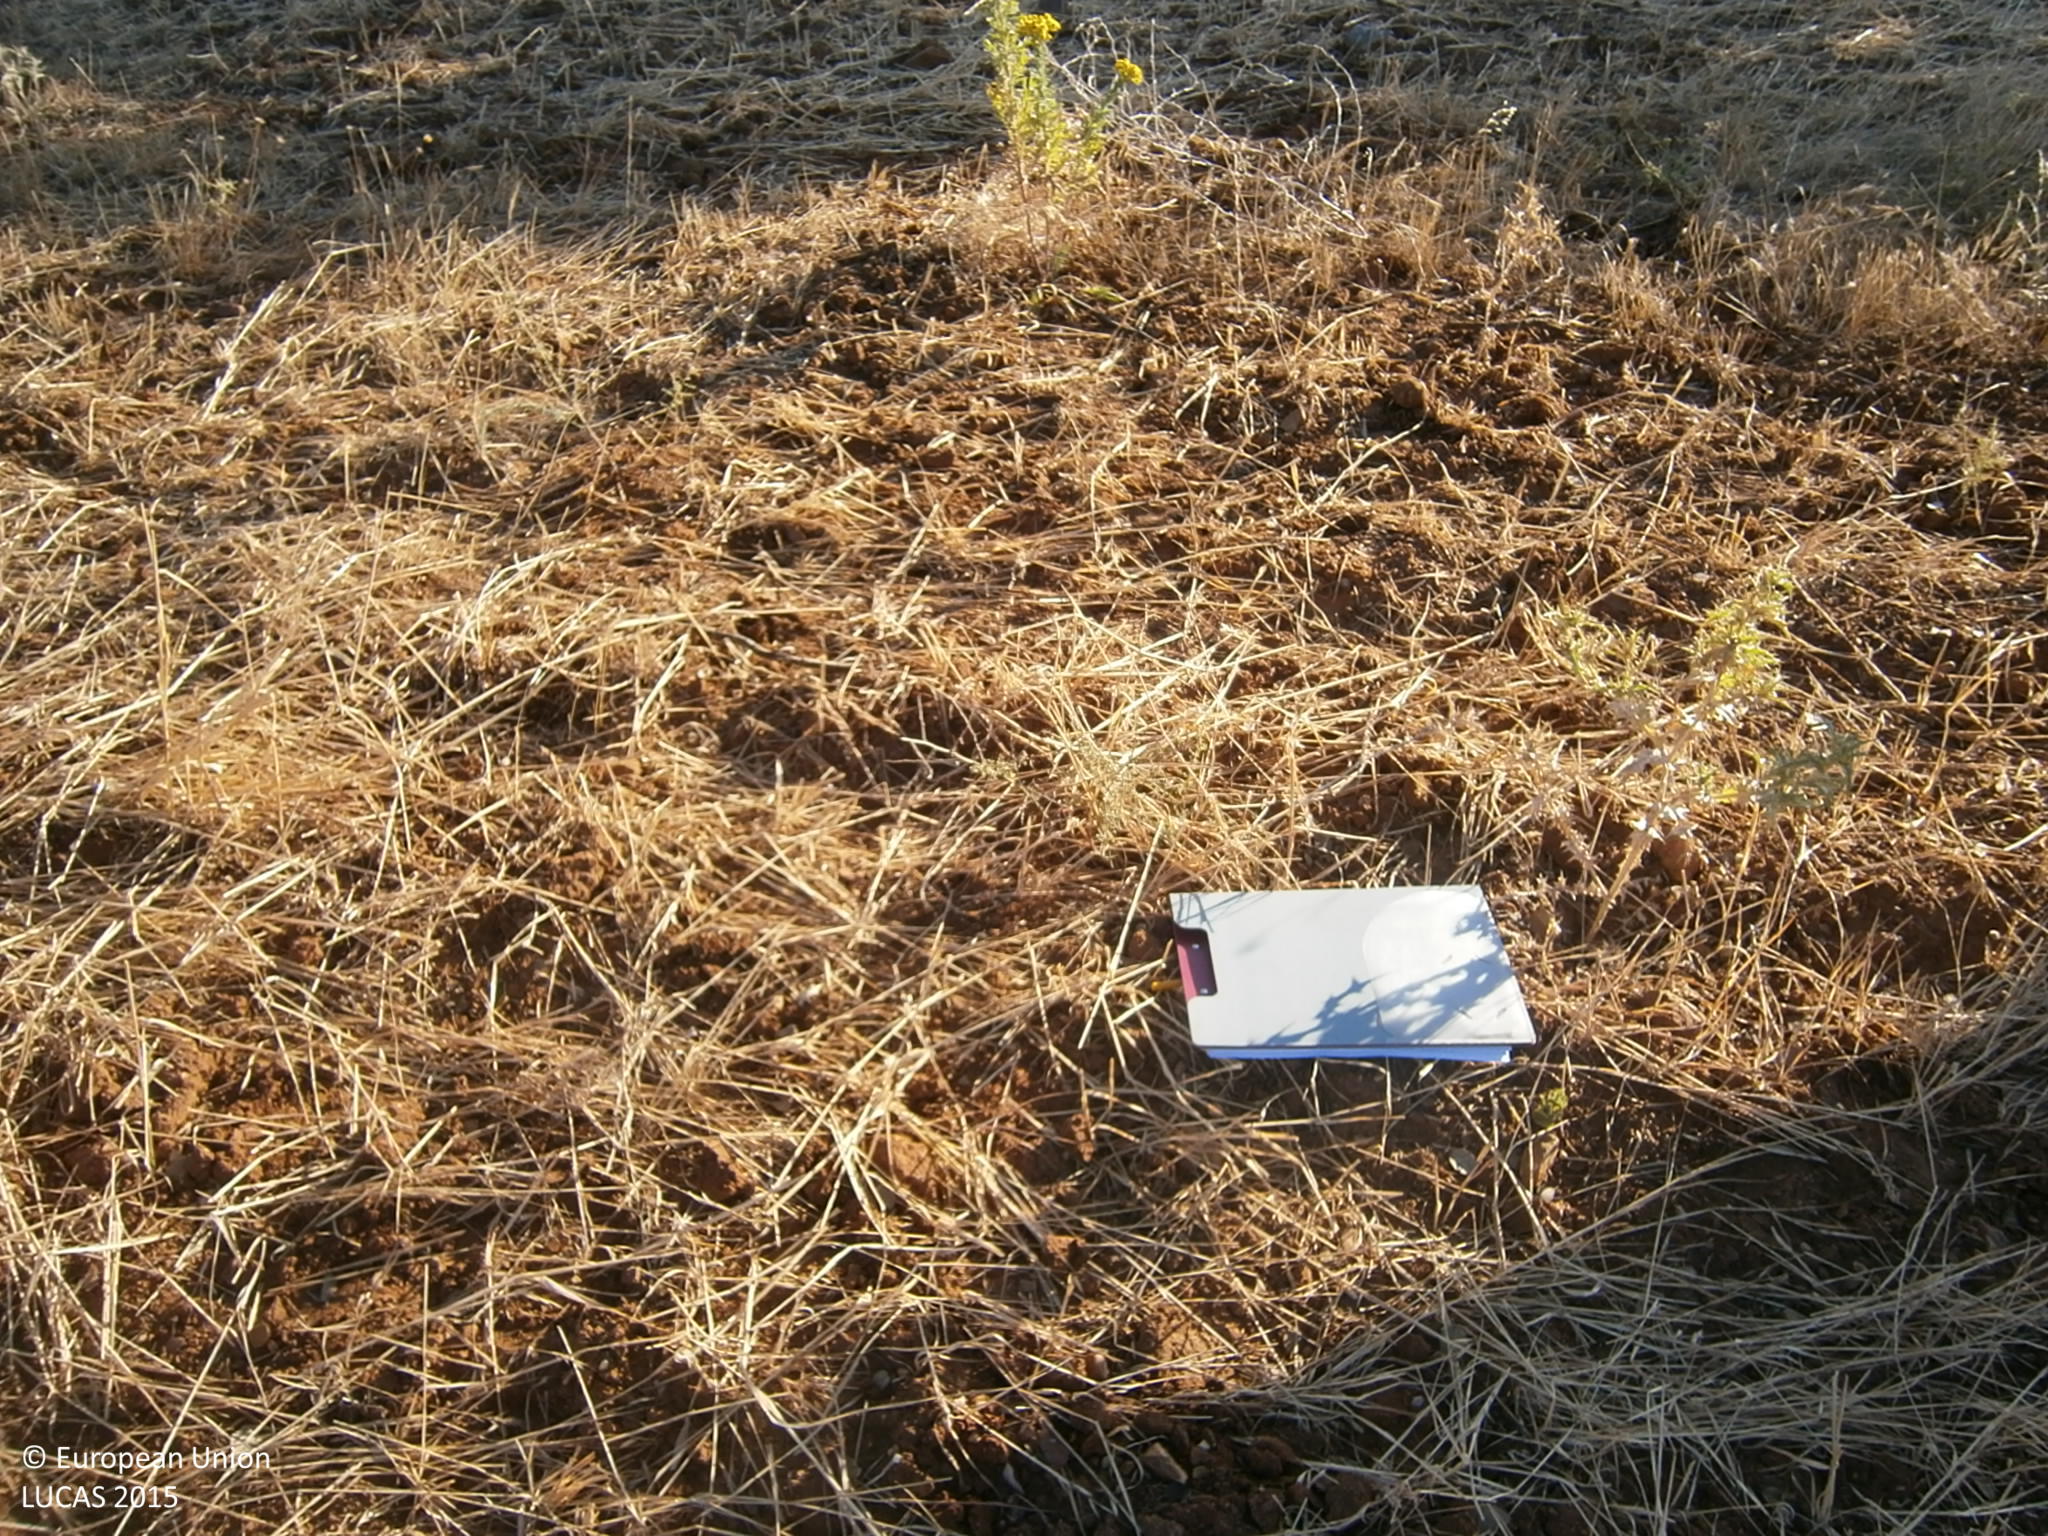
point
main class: Woodland
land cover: Broadleaved woodland
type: broadleaved evergreen forest
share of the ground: 50 - 75 %
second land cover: Spontaneously vegetated surfaces
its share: 50 - 75 %
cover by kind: broadleaved forest trees 45 %, herbaceous plants 45 %, shrubs 5 %, unconsolidated bare surface 5 %
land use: Forestry
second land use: Agriculture (excluding fallow land and kitchen gardens)
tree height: > 5 m
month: June
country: ES
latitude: 38.8449
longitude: -6.4773
